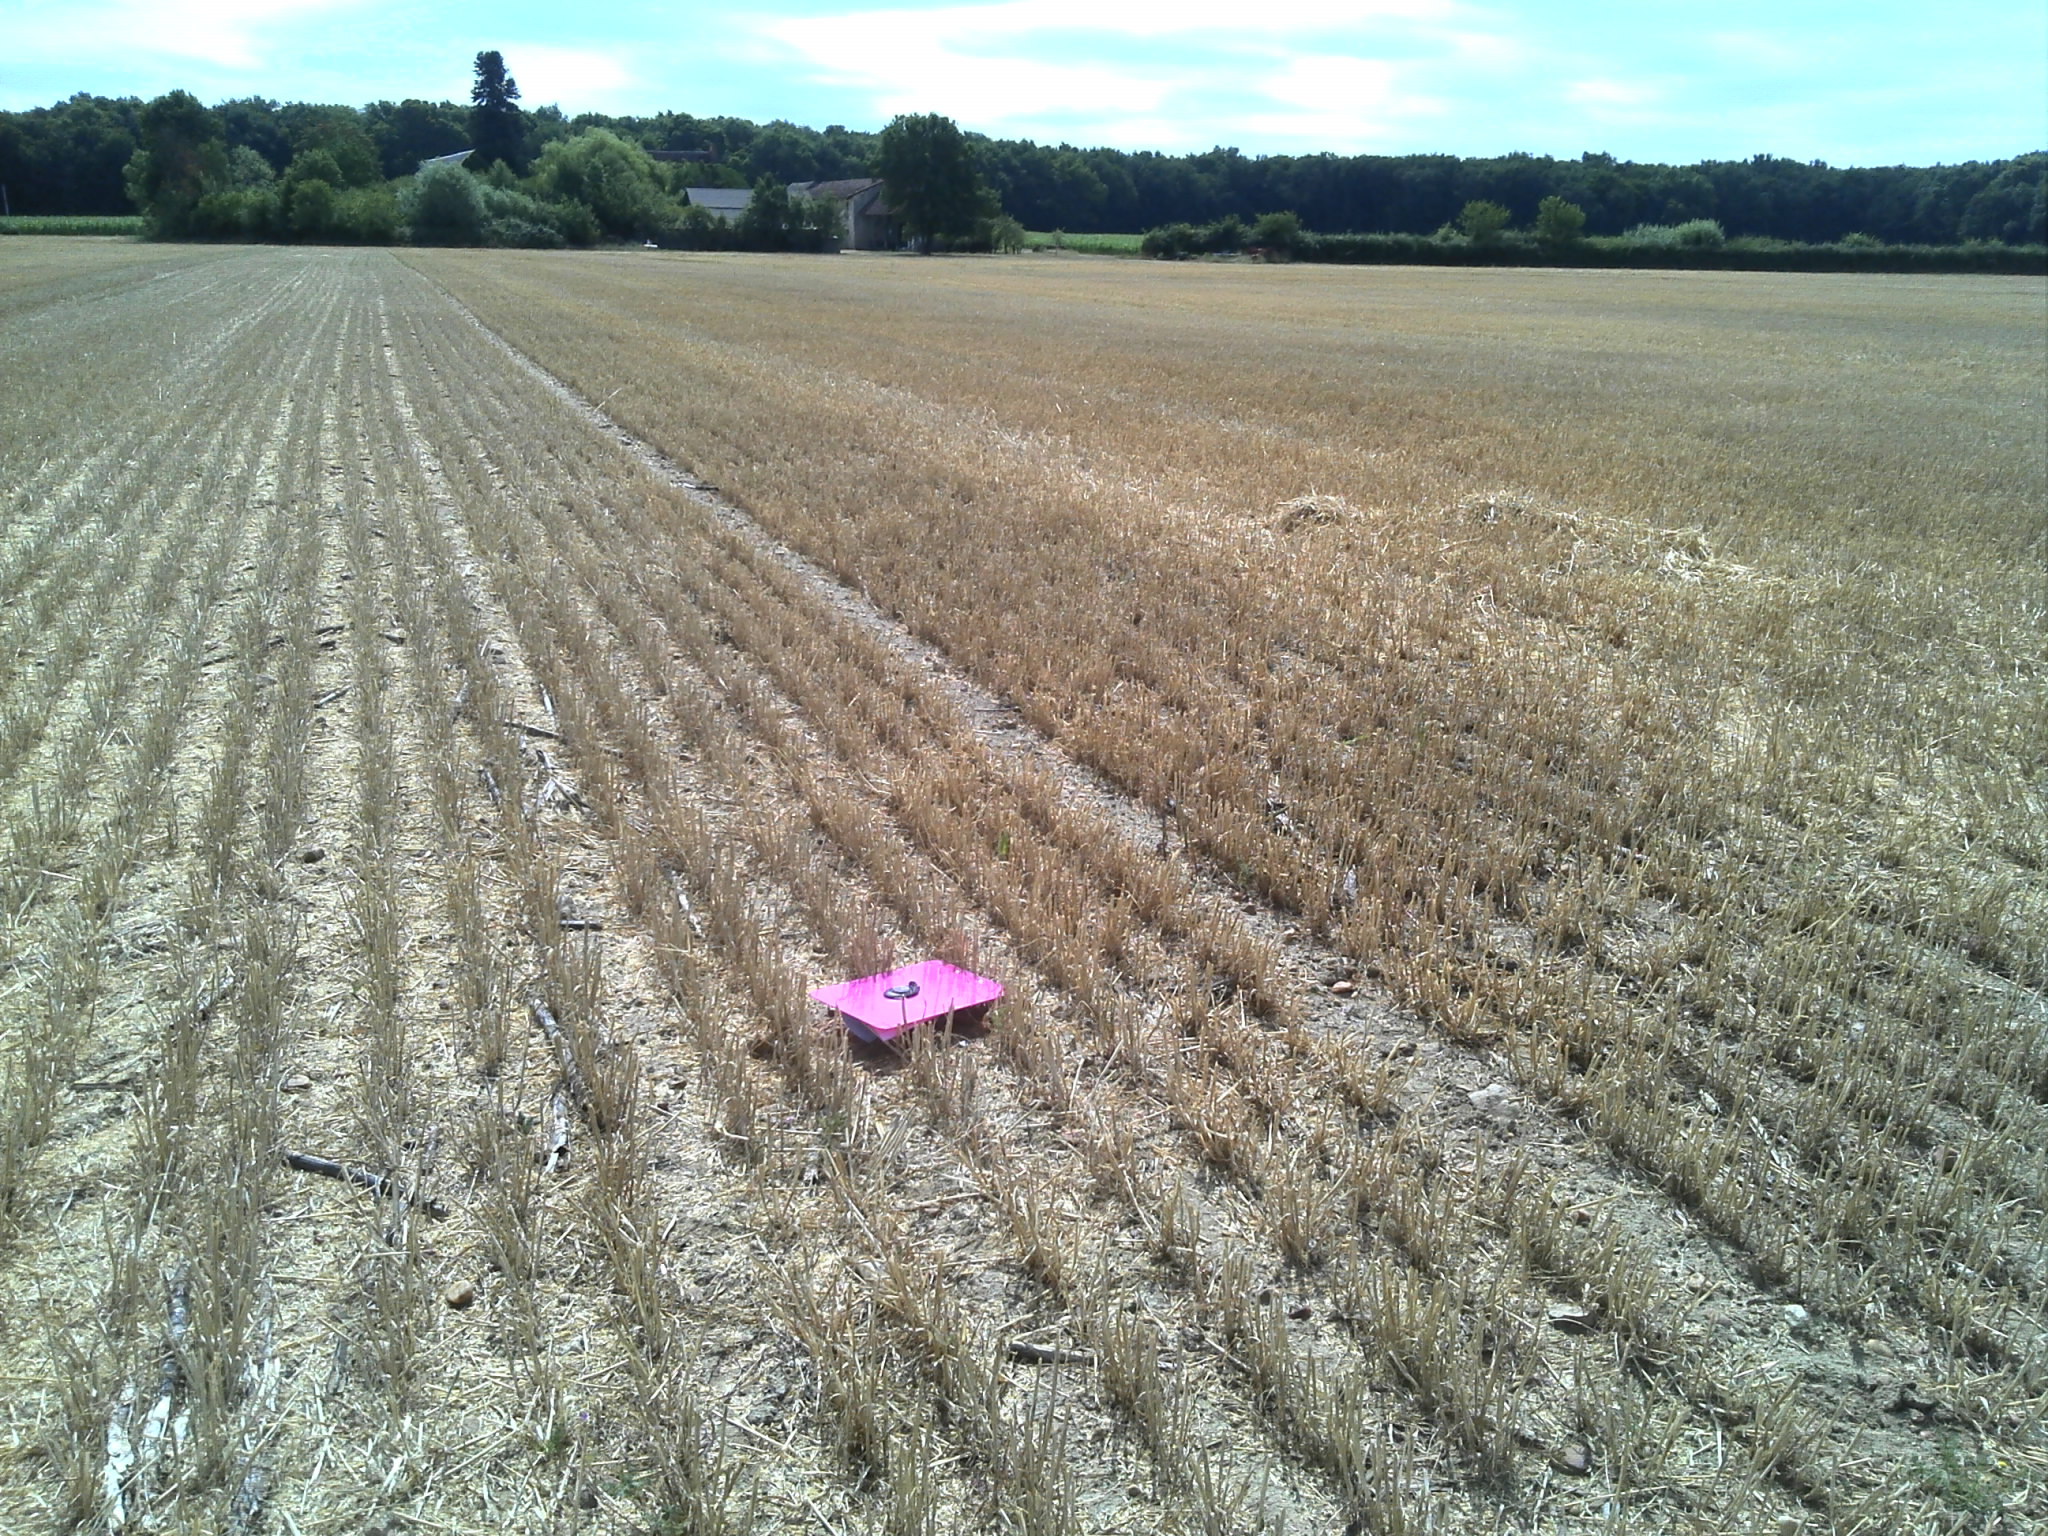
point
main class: Cropland
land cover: Durum wheat
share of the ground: 10 - 25 %
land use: Agriculture (excluding fallow land and kitchen gardens)
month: July
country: FR
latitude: 46.7940
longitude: 1.5387
